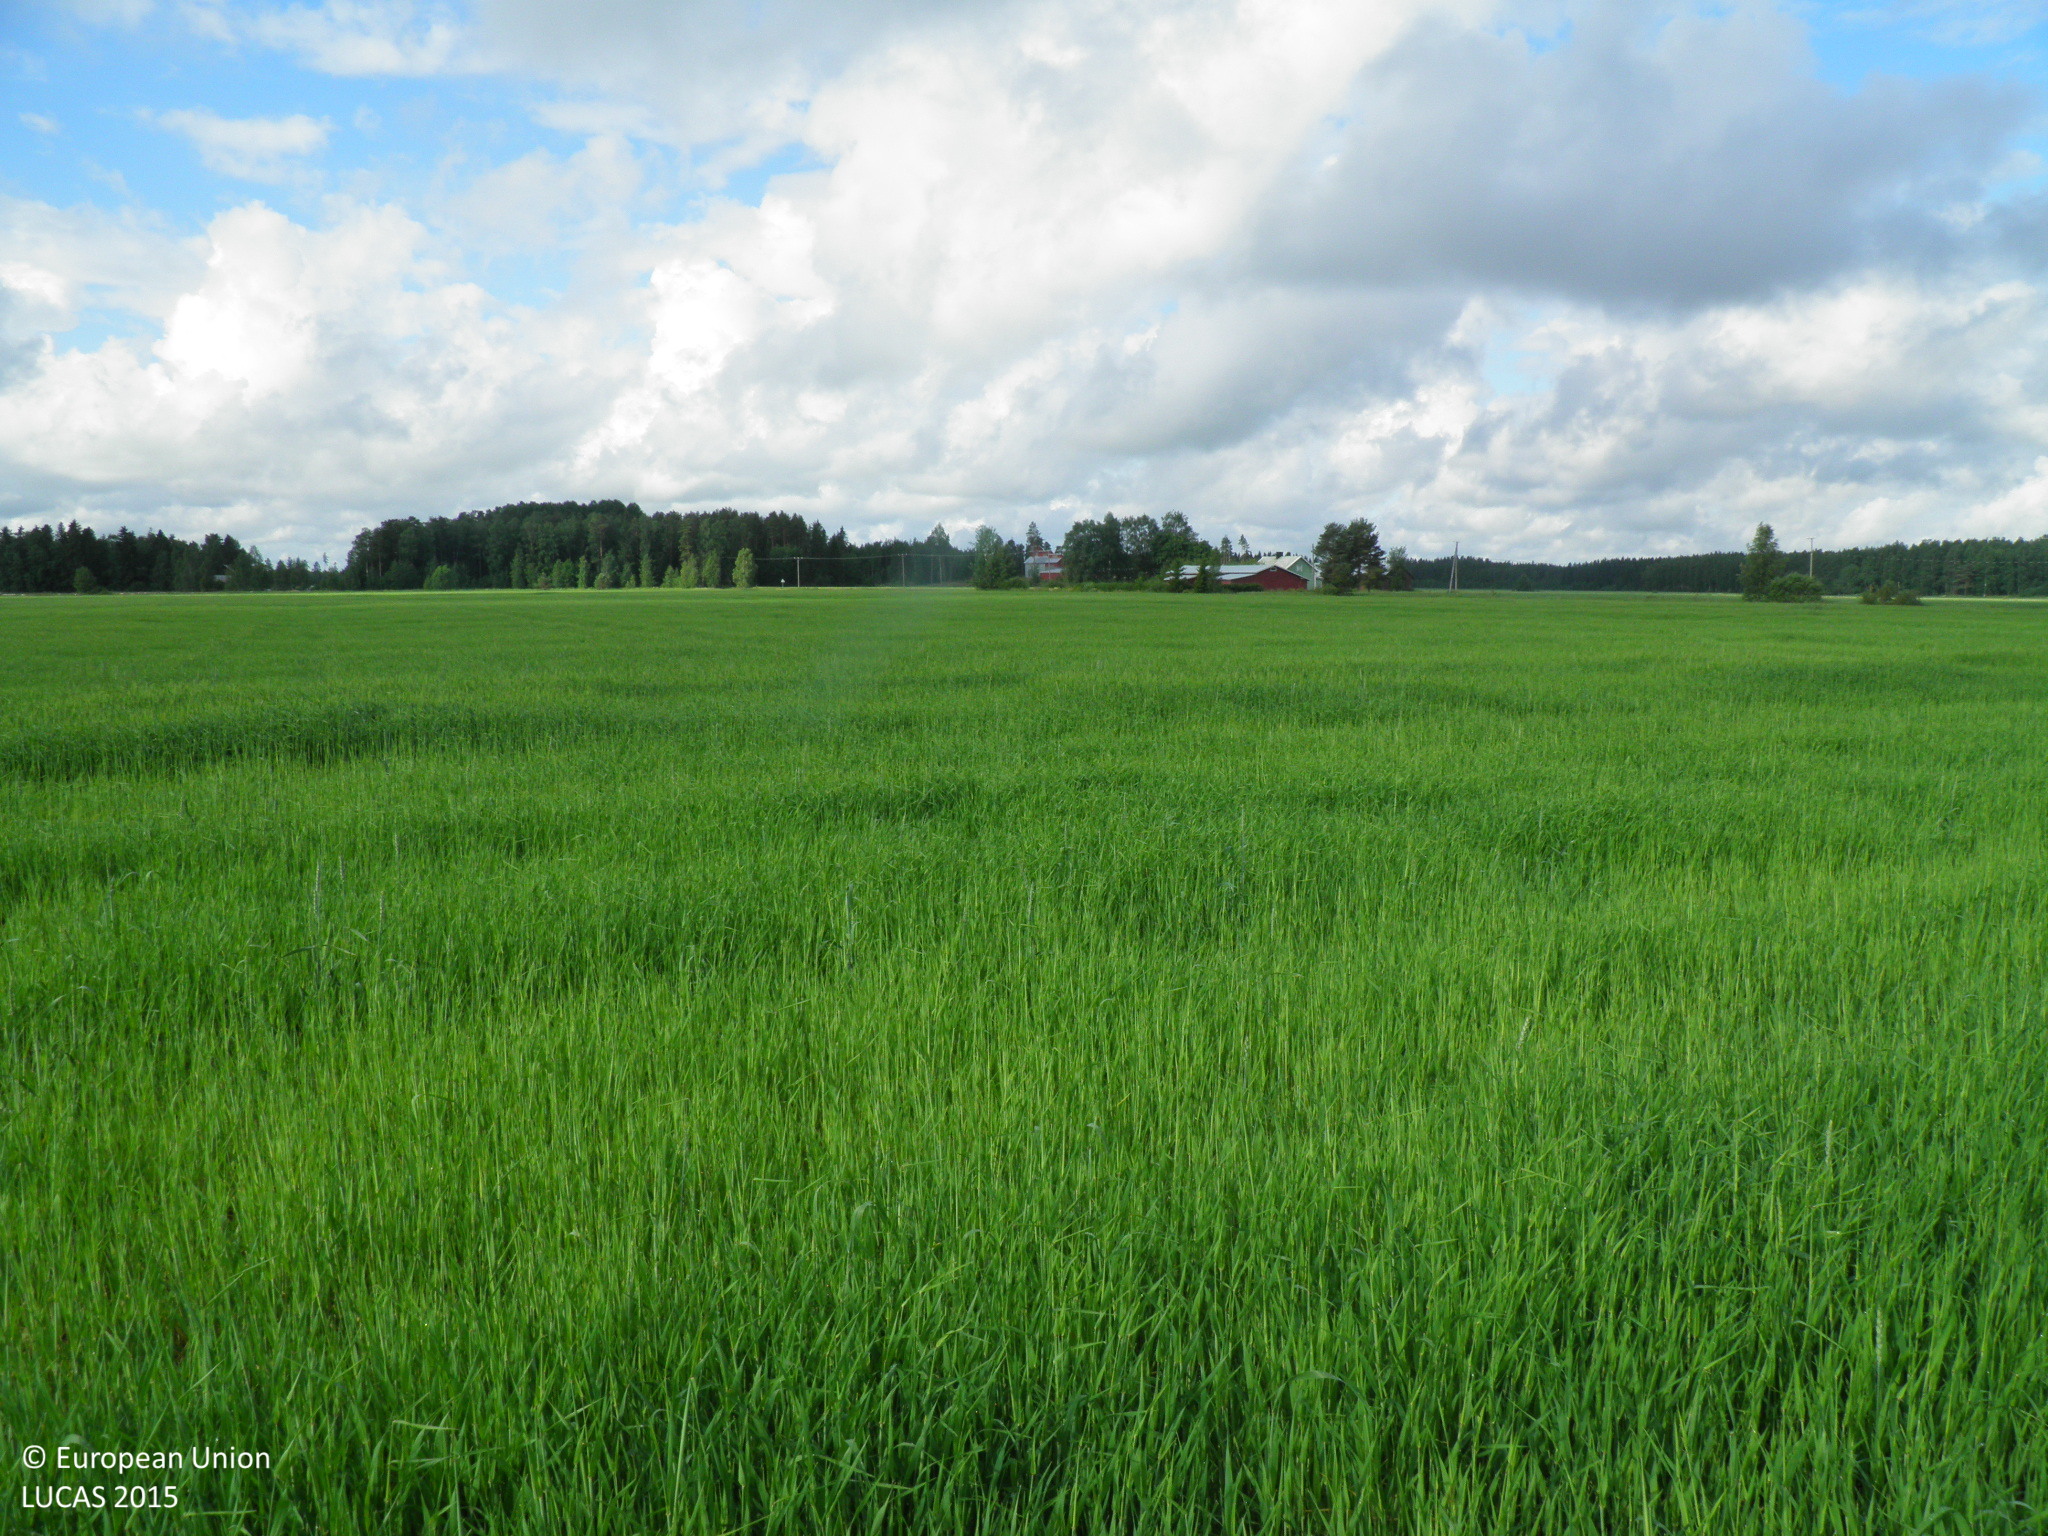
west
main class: Cropland
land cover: Barley
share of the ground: > 75 %
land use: Agriculture (excluding fallow land and kitchen gardens)
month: July
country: FI
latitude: 60.7792
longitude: 22.8363
